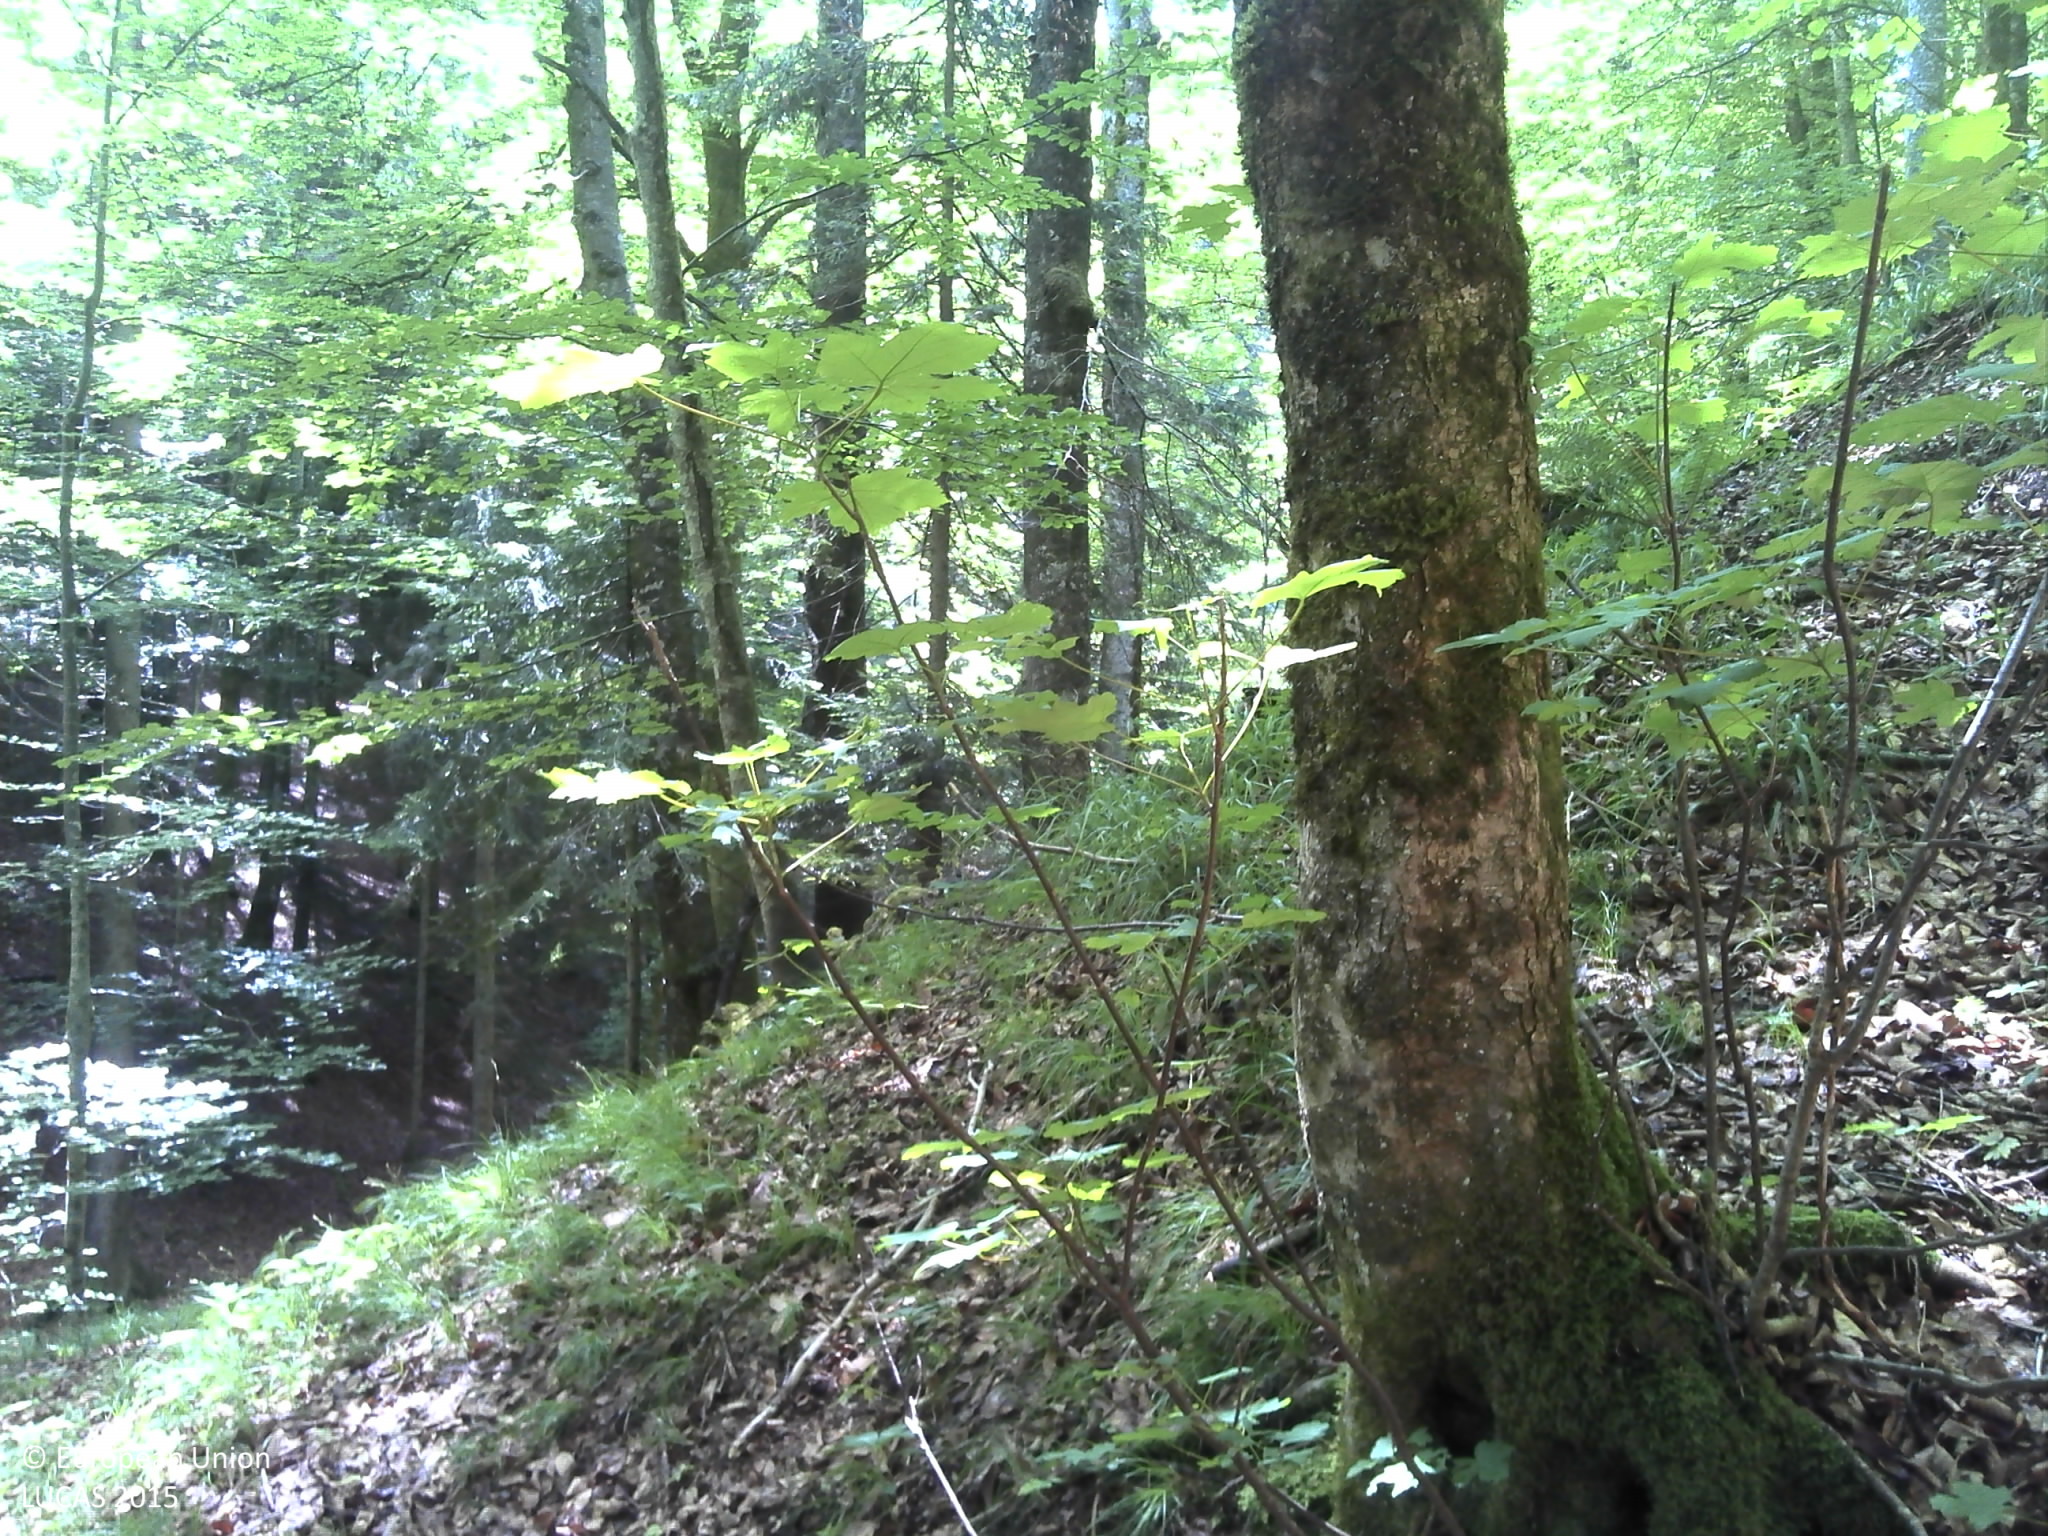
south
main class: Woodland
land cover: Broadleaved woodland
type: beech forest
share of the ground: > 75 %
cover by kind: broadleaved forest trees 95 %, consolidated bare surface 5 %
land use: Semi-natural and natural areas not in use
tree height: > 5 m
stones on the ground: < 10 %
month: June
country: HR
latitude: 44.8486
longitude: 15.6249
